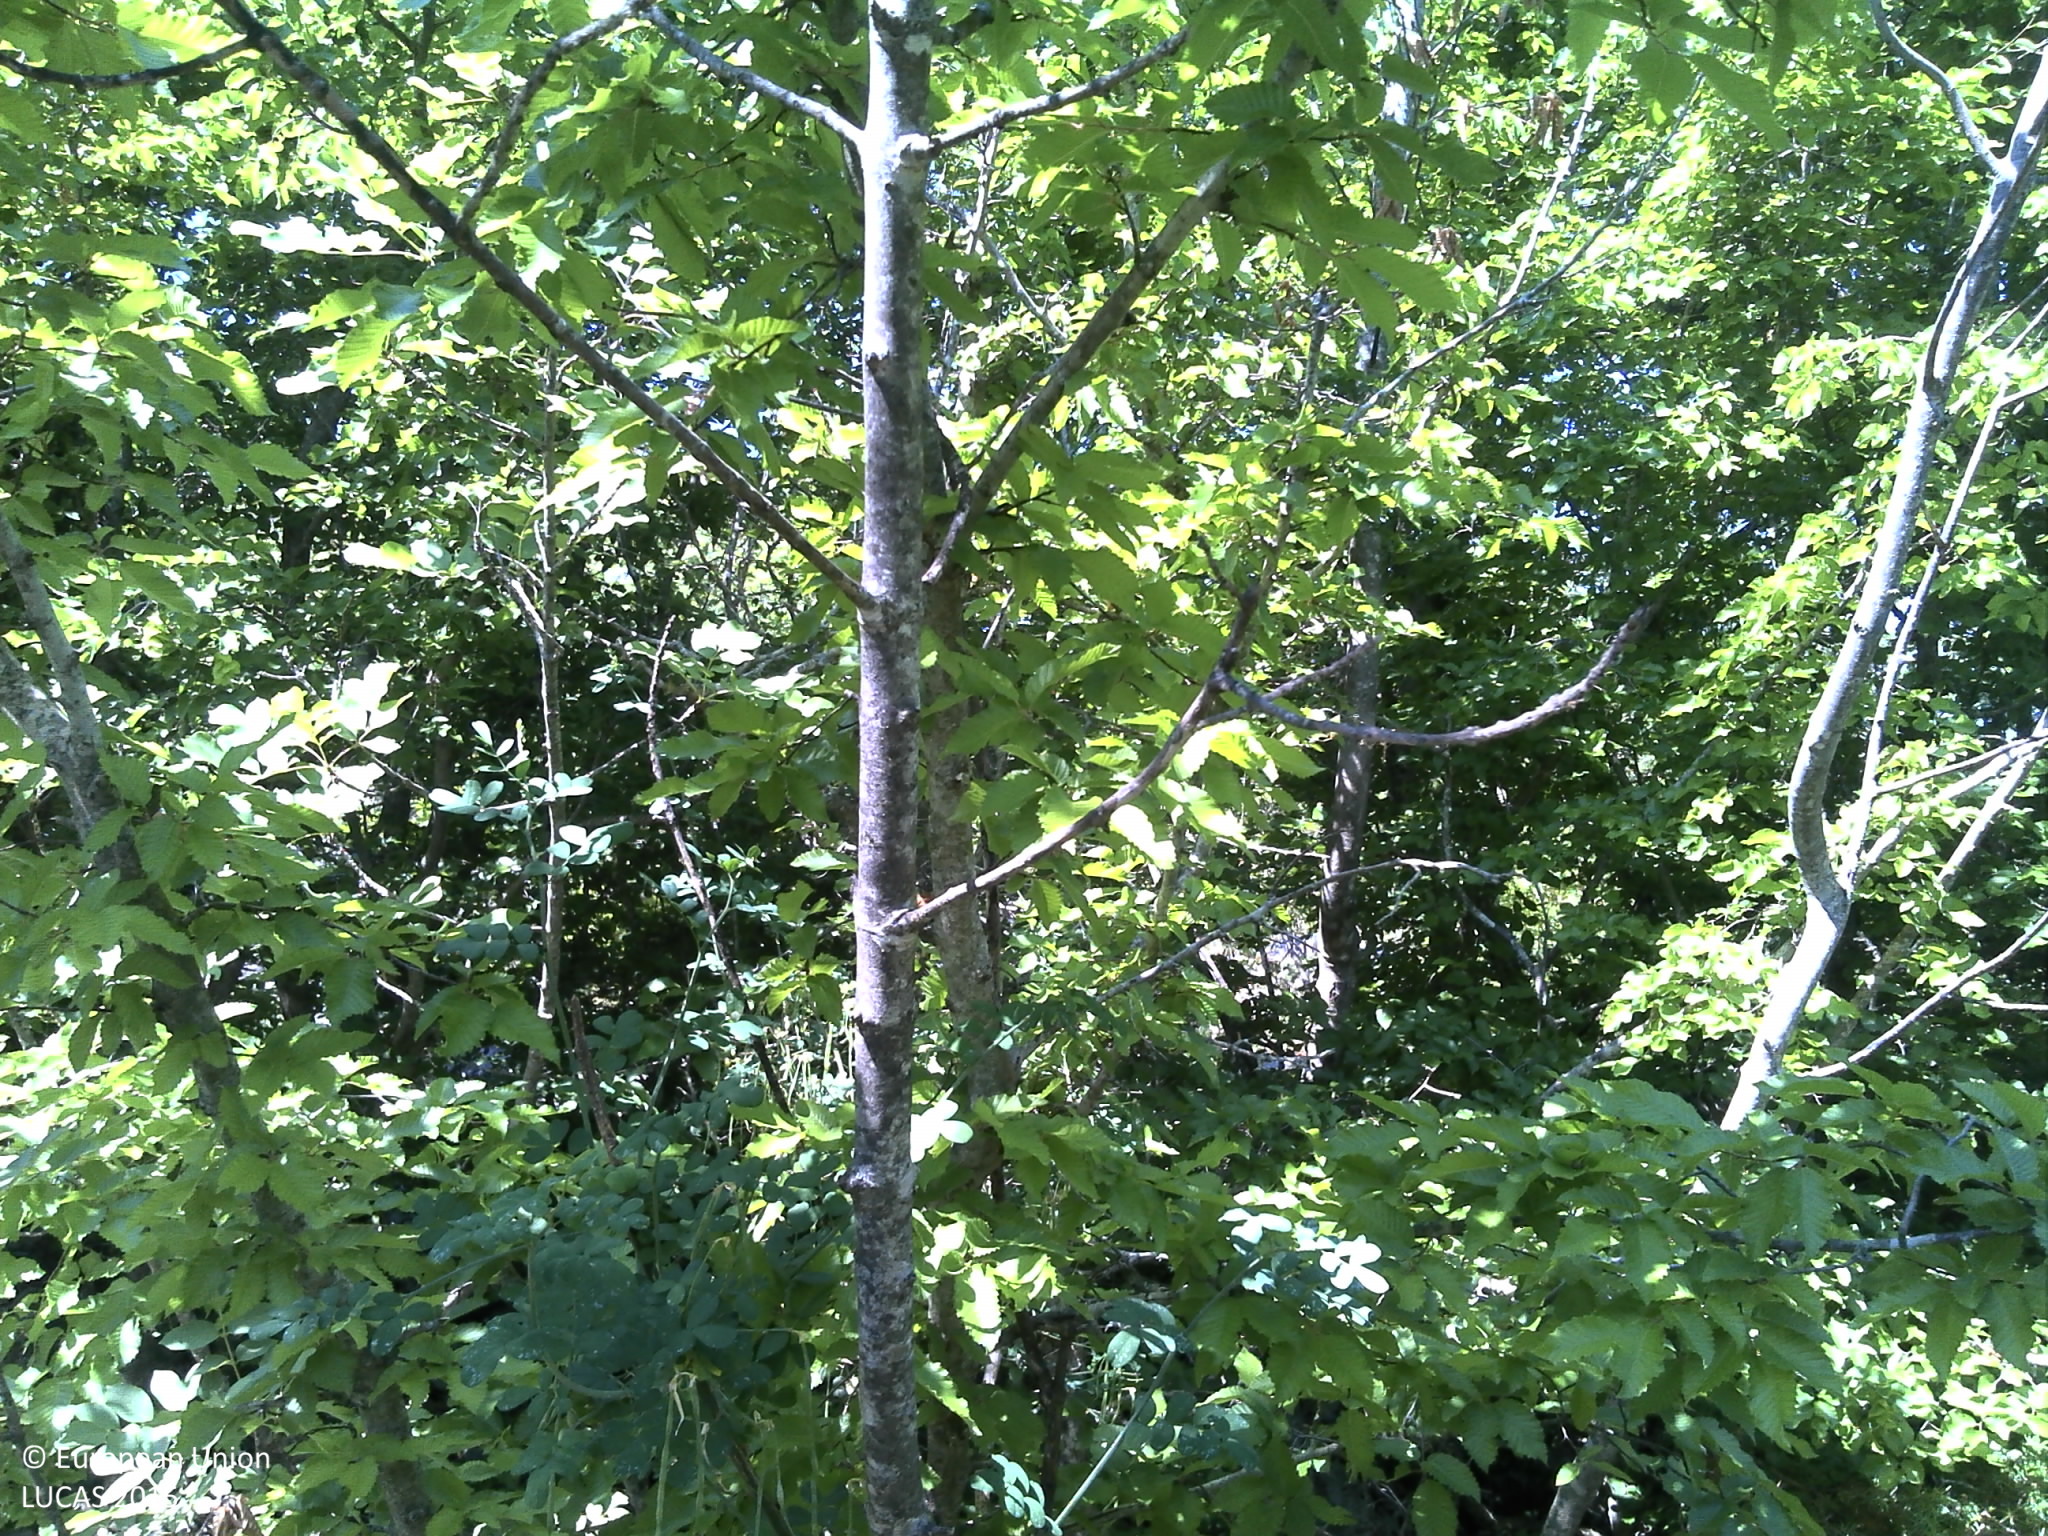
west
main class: Woodland
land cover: Broadleaved woodland
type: thermophilous deciduous forest
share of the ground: > 75 %
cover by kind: broadleaved forest trees 80 %, consolidated bare surface 10 %, herbaceous plants 5 %, unconsolidated bare surface 5 %
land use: Semi-natural and natural areas not in use
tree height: > 5 m
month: June
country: HR
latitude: 43.5594
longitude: 16.0442
